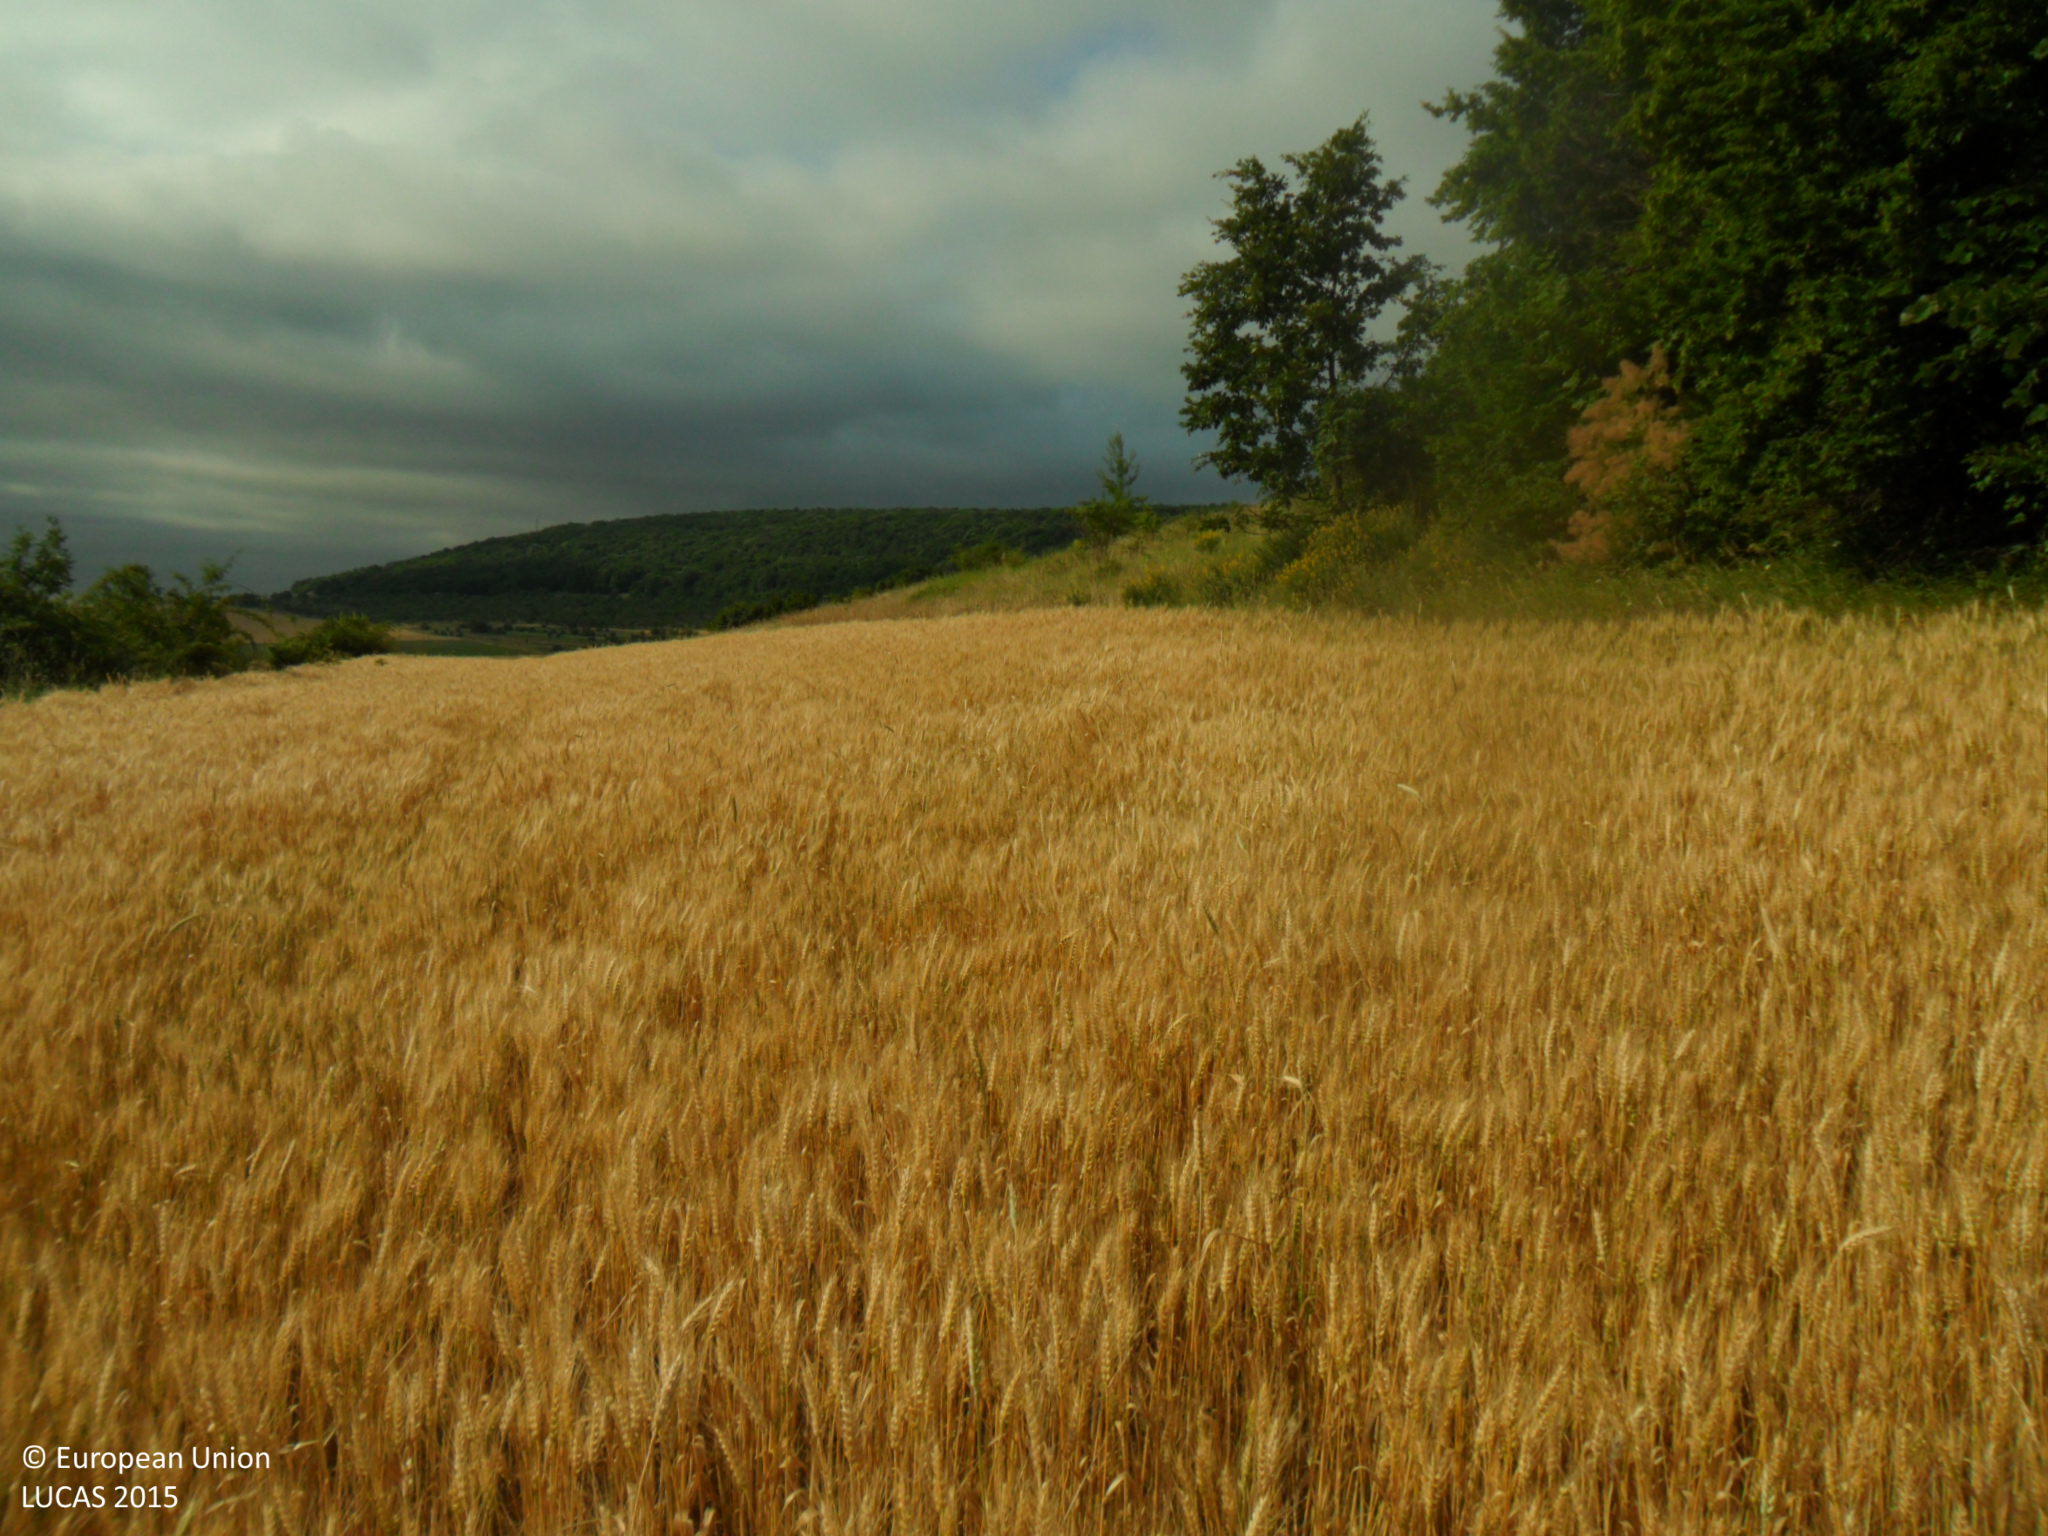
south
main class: Cropland
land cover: Common wheat
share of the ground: > 75 %
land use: Agriculture (excluding fallow land and kitchen gardens)
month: June
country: BG
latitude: 43.4852
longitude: 27.1216
